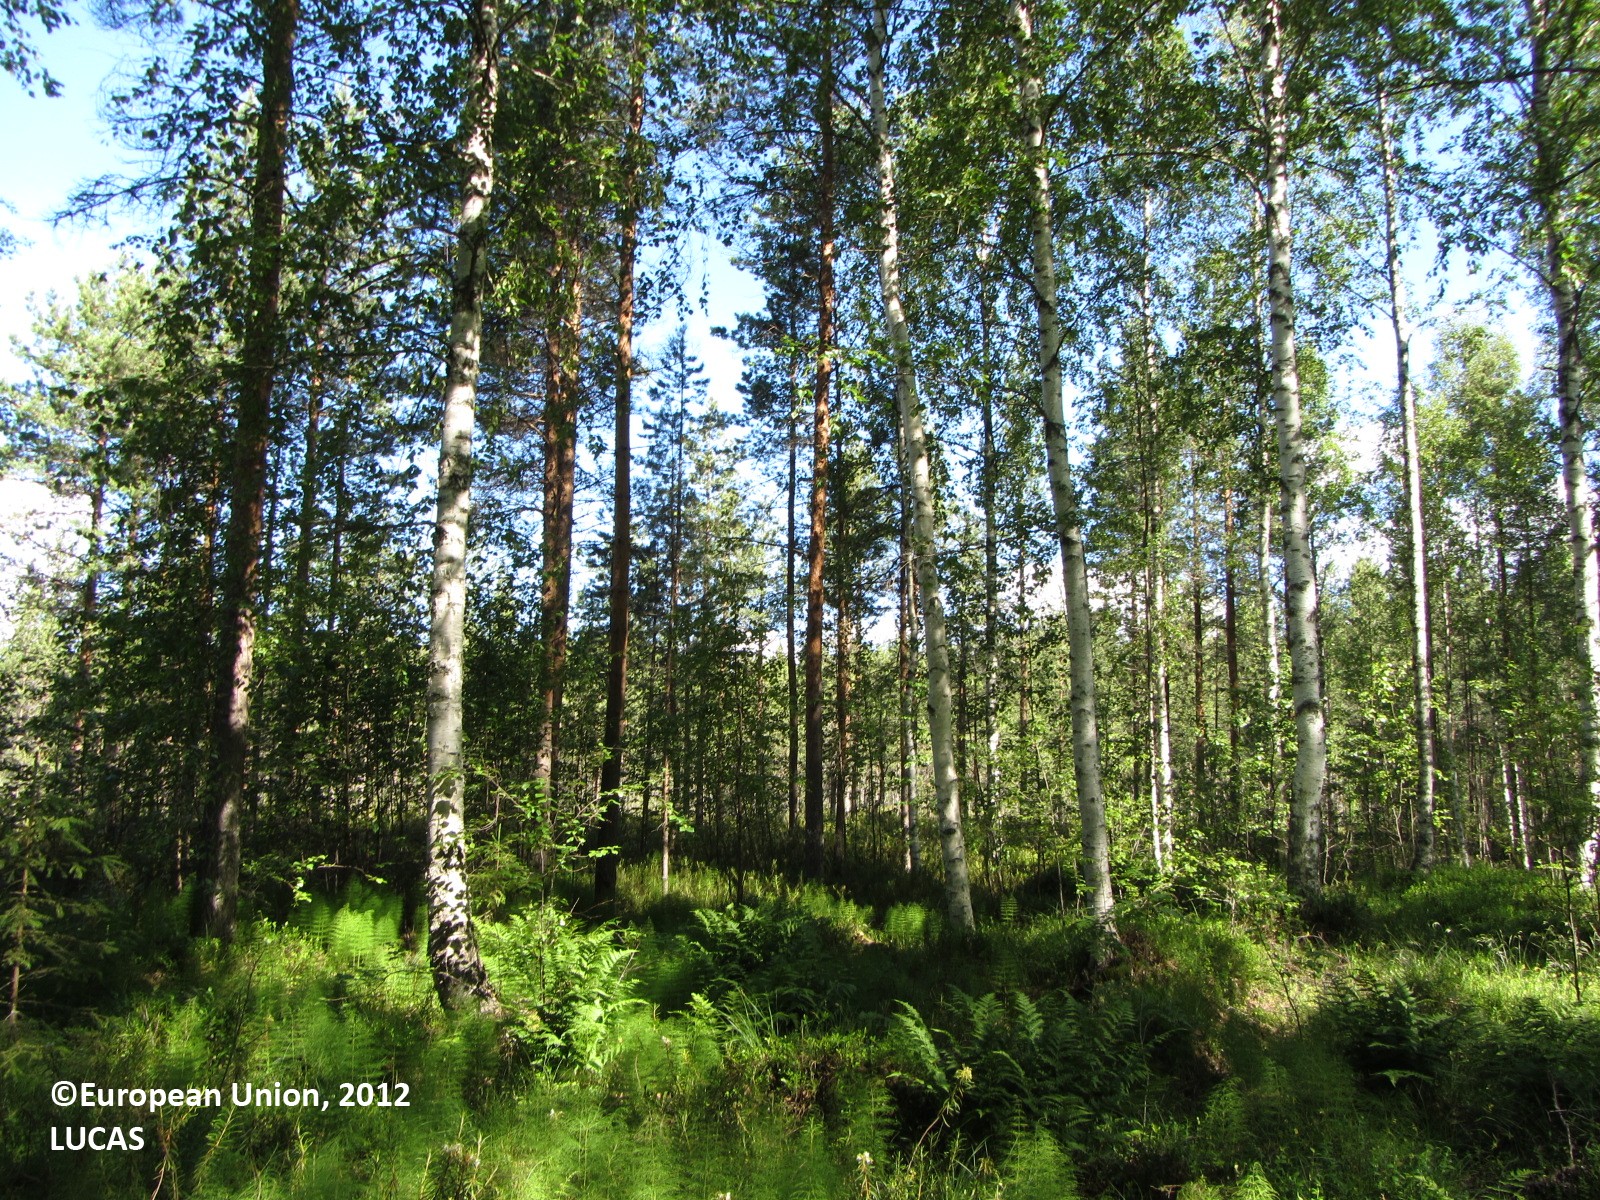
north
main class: Woodland
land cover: Other mixed woodland
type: boreal forest
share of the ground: > 75 %
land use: Forestry
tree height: > 5 m
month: July
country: FI
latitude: 63.1004
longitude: 25.2560
